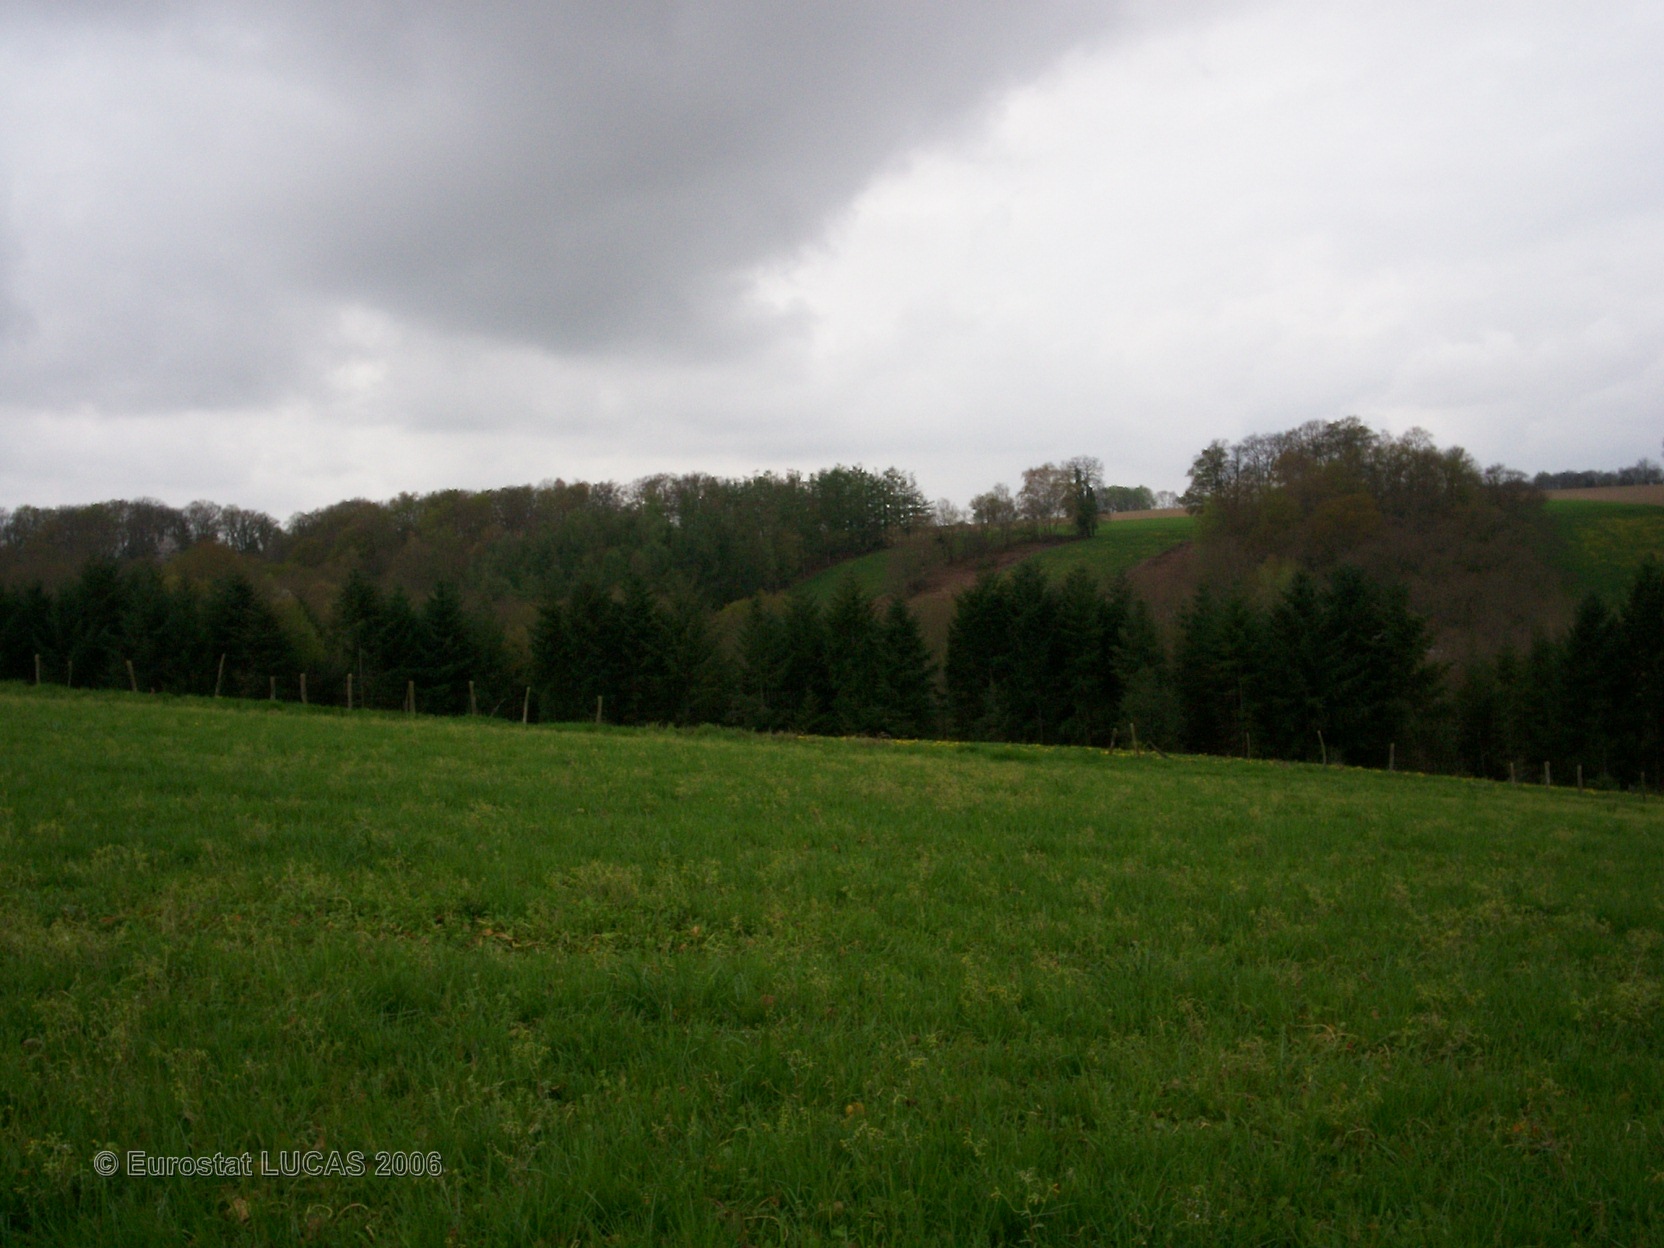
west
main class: Grassland
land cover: Grassland without tree/shrub cover
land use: Agriculture (excluding fallow land and kitchen gardens)
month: April
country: FR
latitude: 43.3933
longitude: -0.1913
